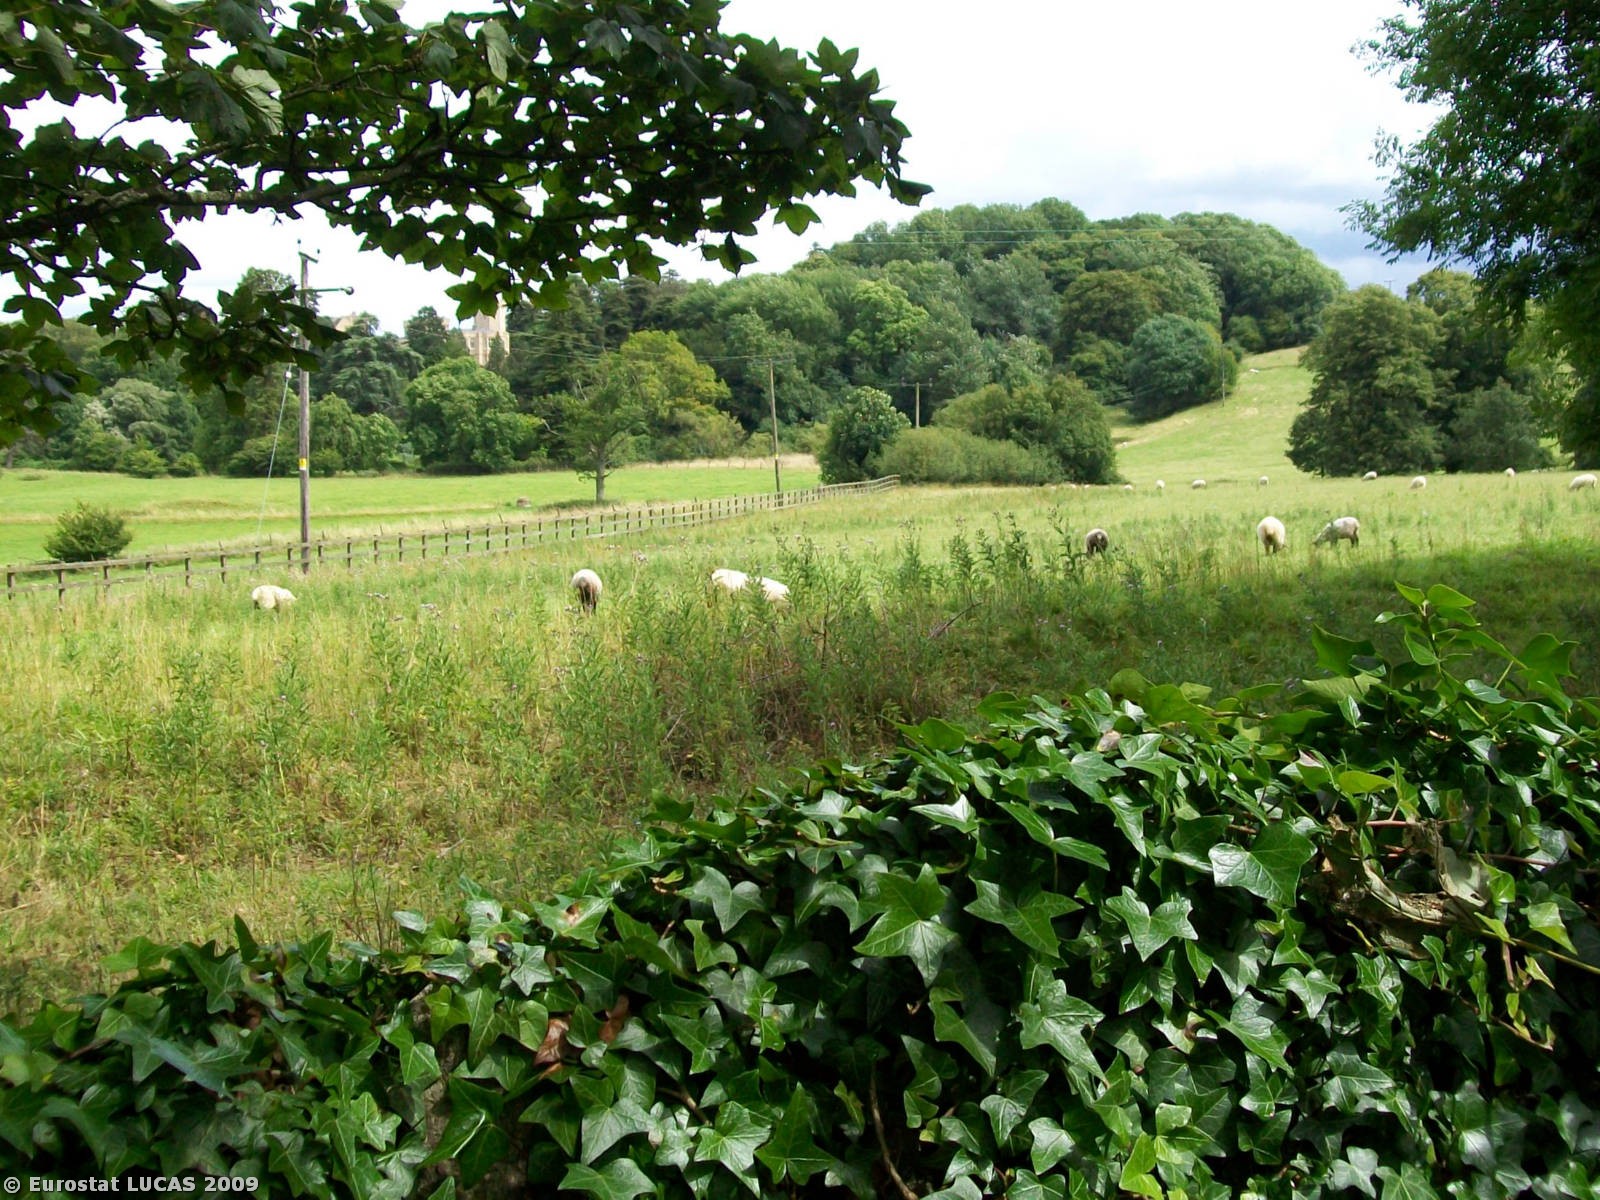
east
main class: Grassland
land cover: Grassland with sparse tree/shrub cover
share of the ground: > 75 %
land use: Agriculture (excluding fallow land and kitchen gardens)
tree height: > 5 m
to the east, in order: Grassland with sparse tree/shrub cover; Fences; Grassland without tree/shrub cover; Broadleaved woodland
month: July
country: GB
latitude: 51.4430
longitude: -2.3071
